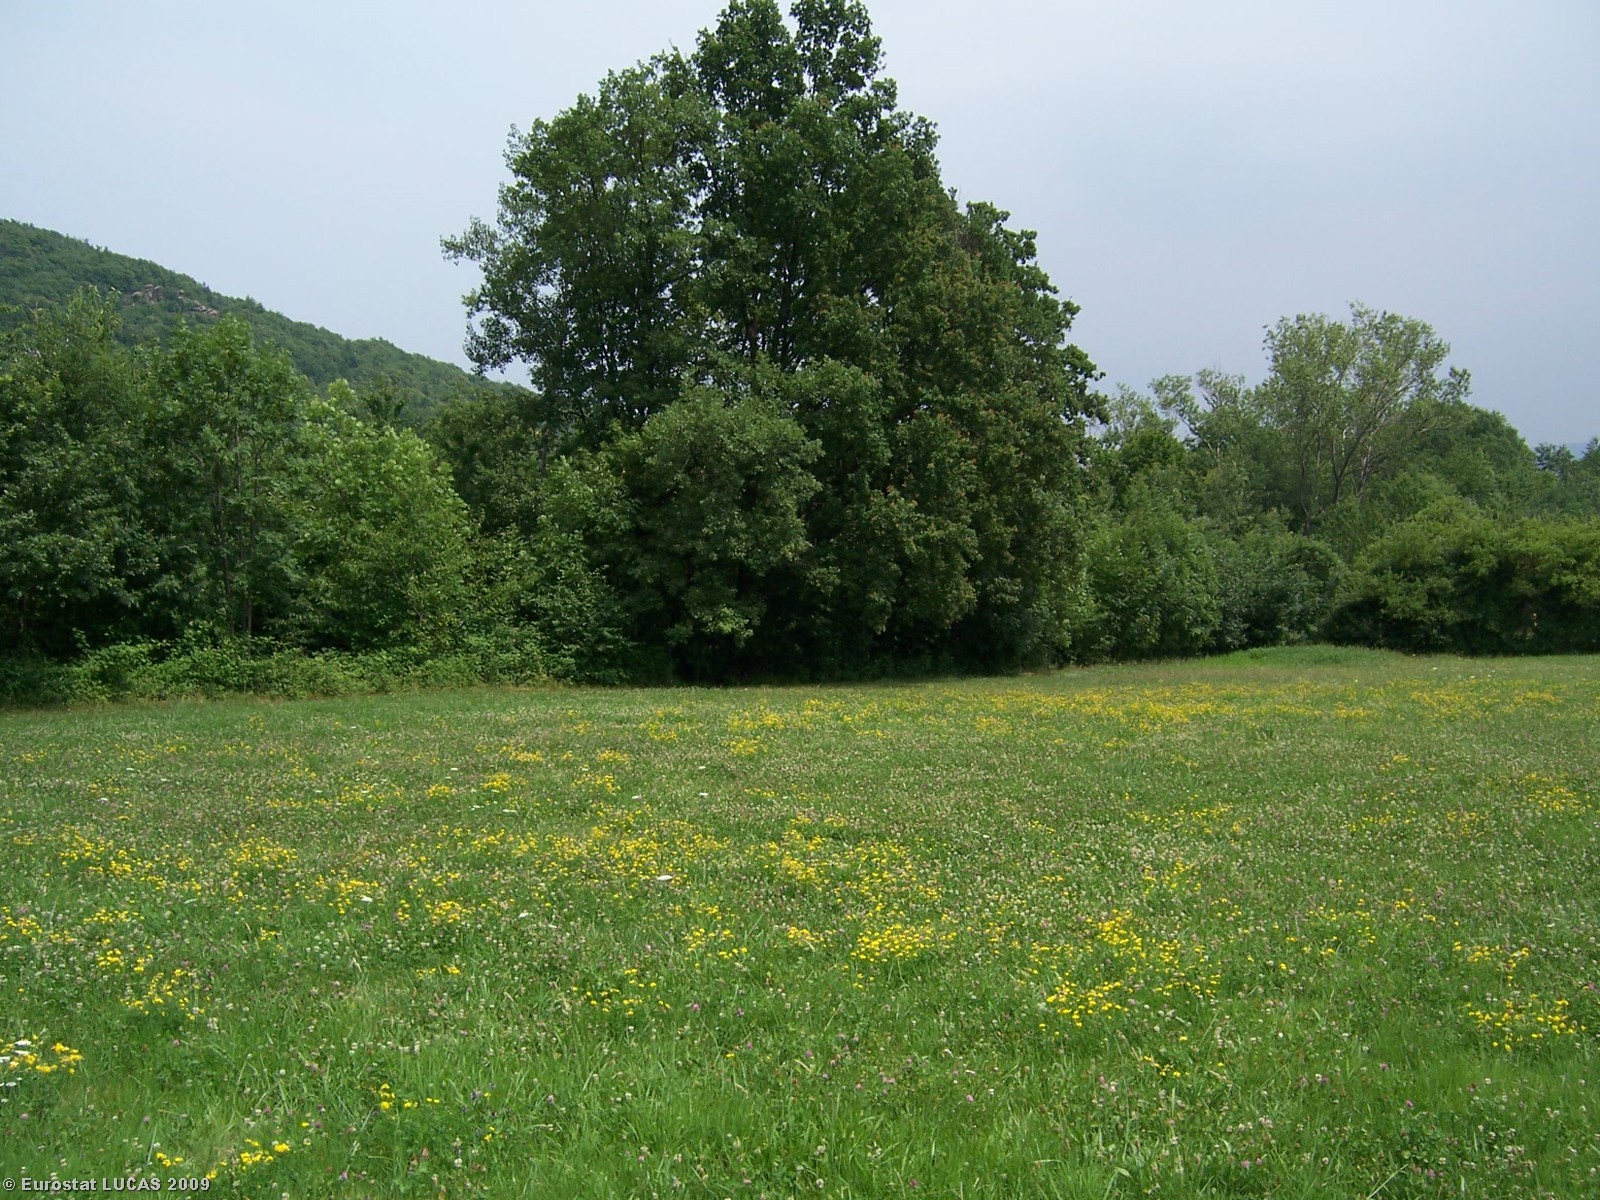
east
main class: Grassland
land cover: Grassland without tree/shrub cover
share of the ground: > 75 %
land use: Agriculture (excluding fallow land and kitchen gardens)
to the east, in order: Grassland without tree/shrub cover; Broadleaved woodland; Paved roads, cycling and walking lanes; Grass margins; Broadleaved woodland
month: July
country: IT
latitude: 45.0558
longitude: 7.3252
